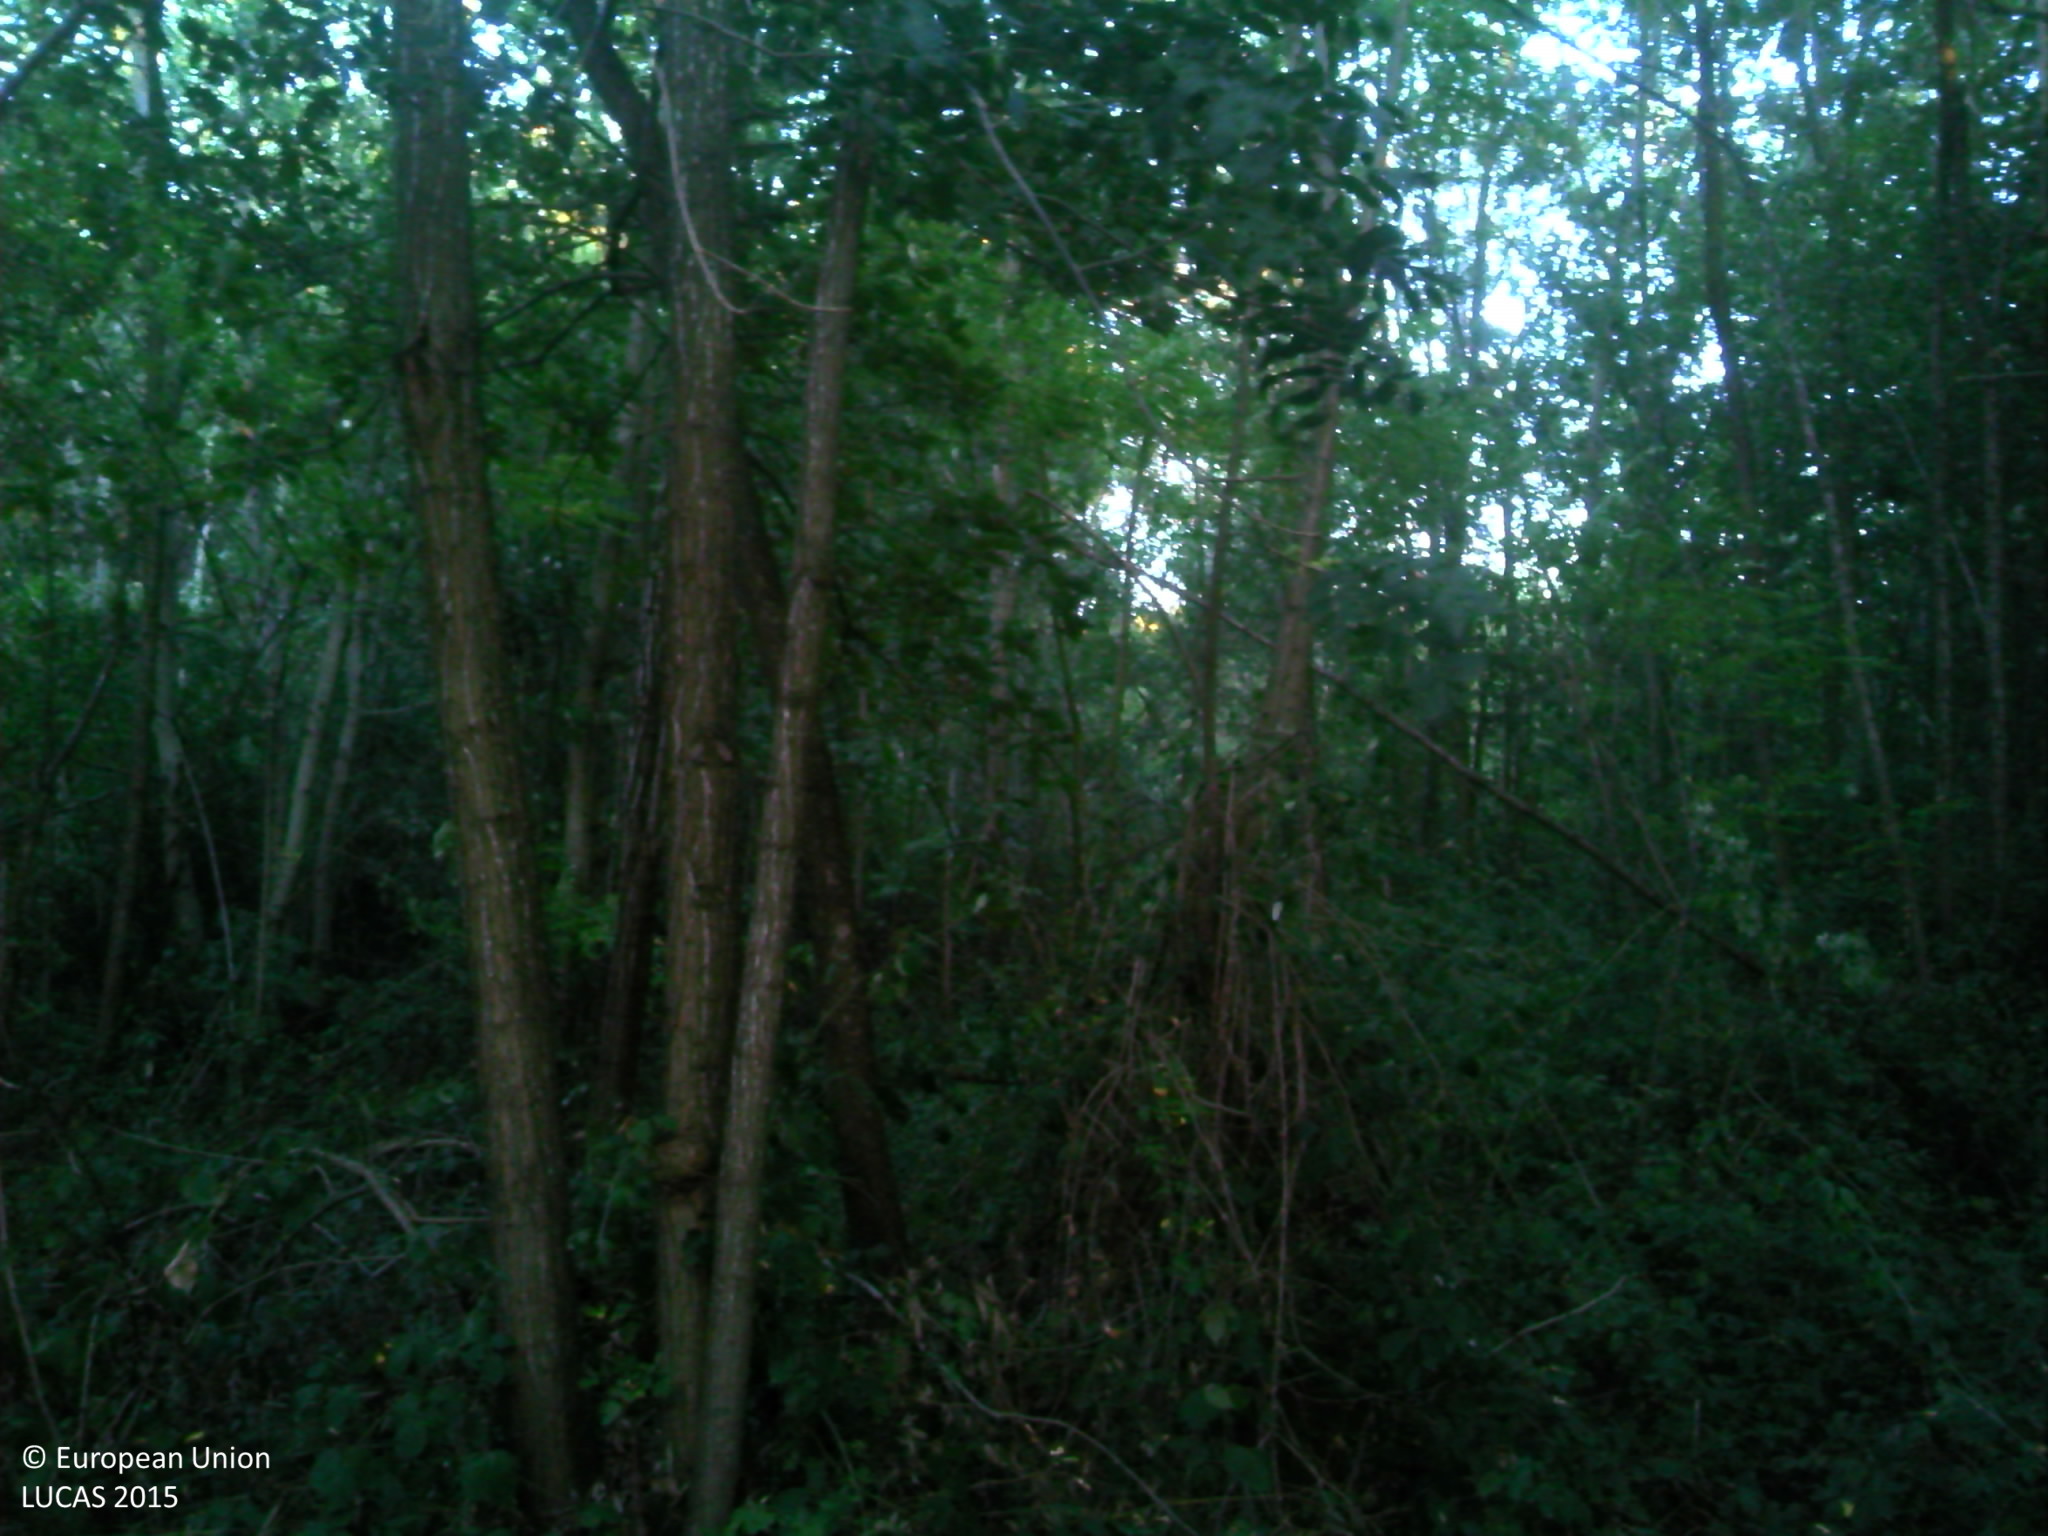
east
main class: Woodland
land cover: Broadleaved woodland
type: mesophytic deciduous forest
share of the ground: > 75 %
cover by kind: broadleaved forest trees 80 %, herbaceous plants 20 %
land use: Forestry
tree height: > 5 m
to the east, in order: Broadleaved woodland; Grass margins; Tracks; Broadleaved woodland
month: September
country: FR
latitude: 45.2067
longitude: 5.0270
